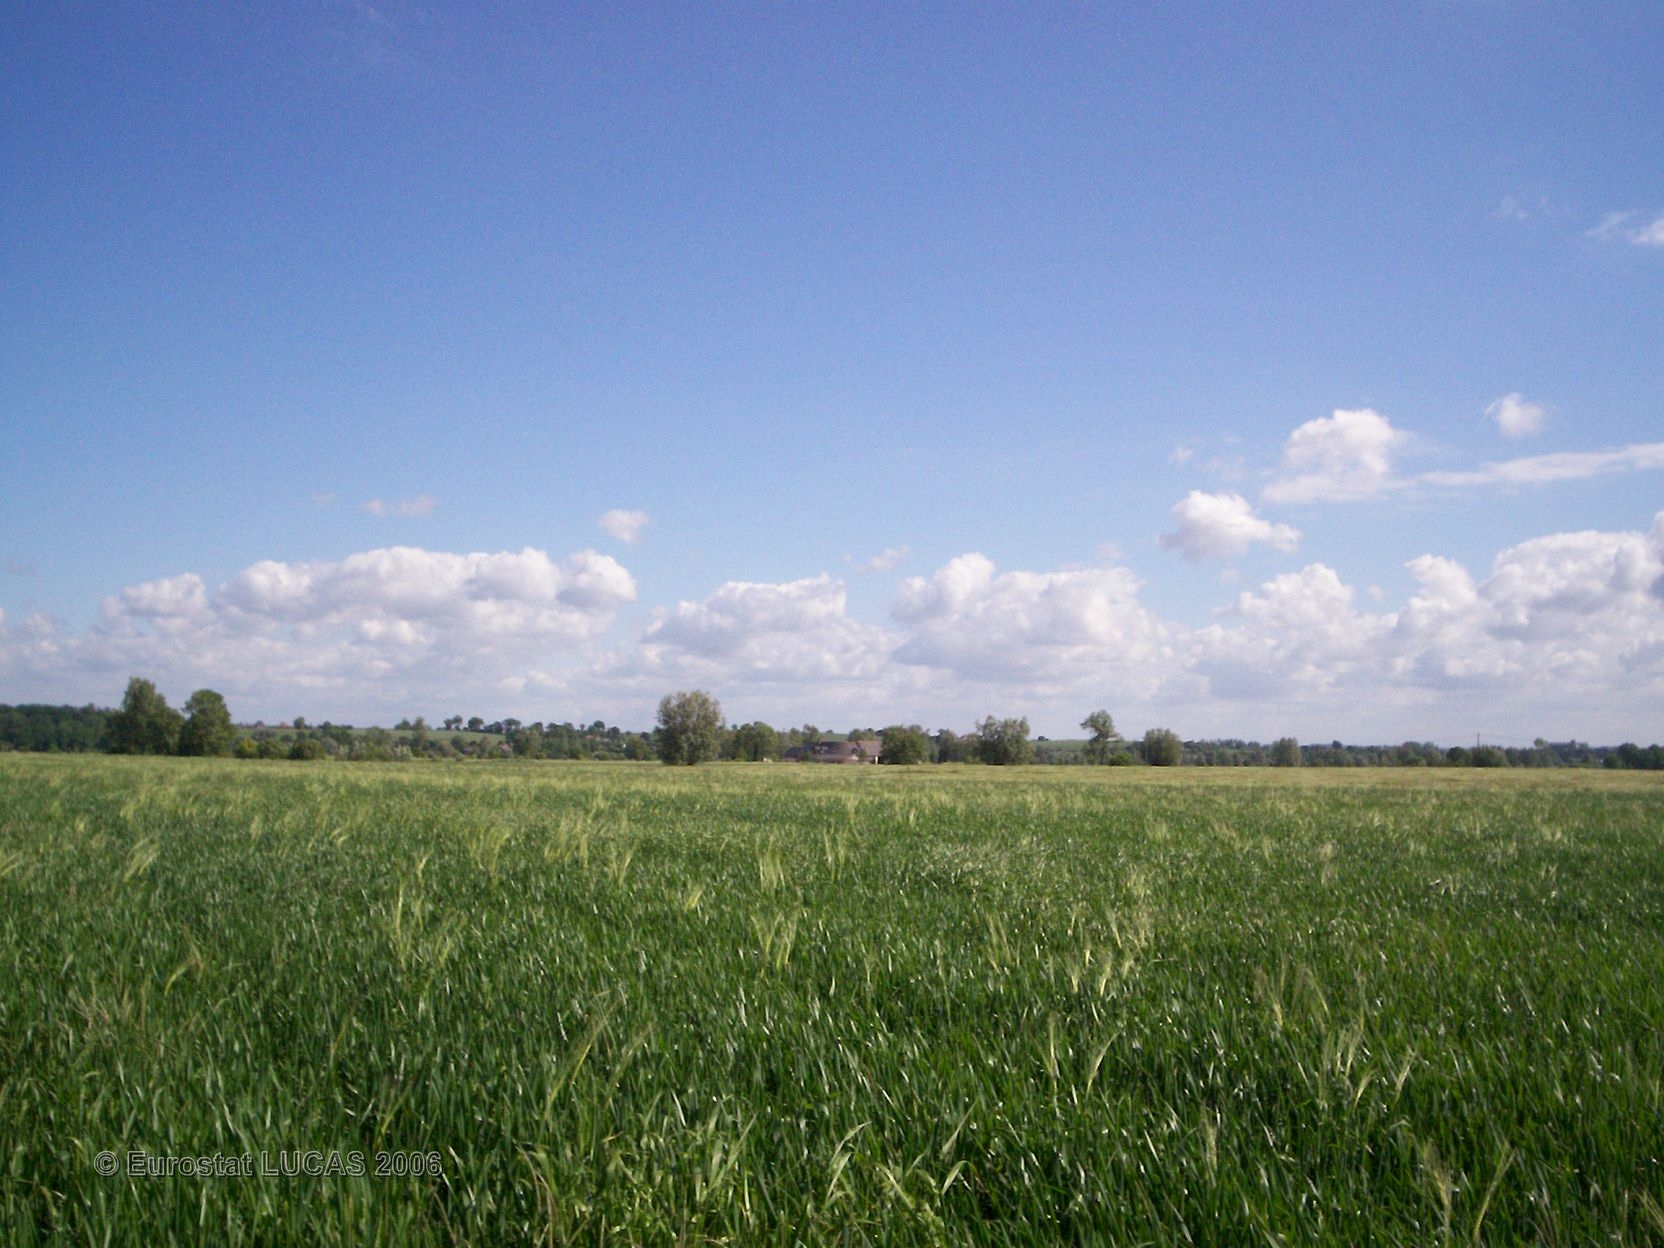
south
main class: Cropland
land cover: Common wheat
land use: Agriculture (excluding fallow land and kitchen gardens)
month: May
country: FR
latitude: 48.5776
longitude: -1.7207
